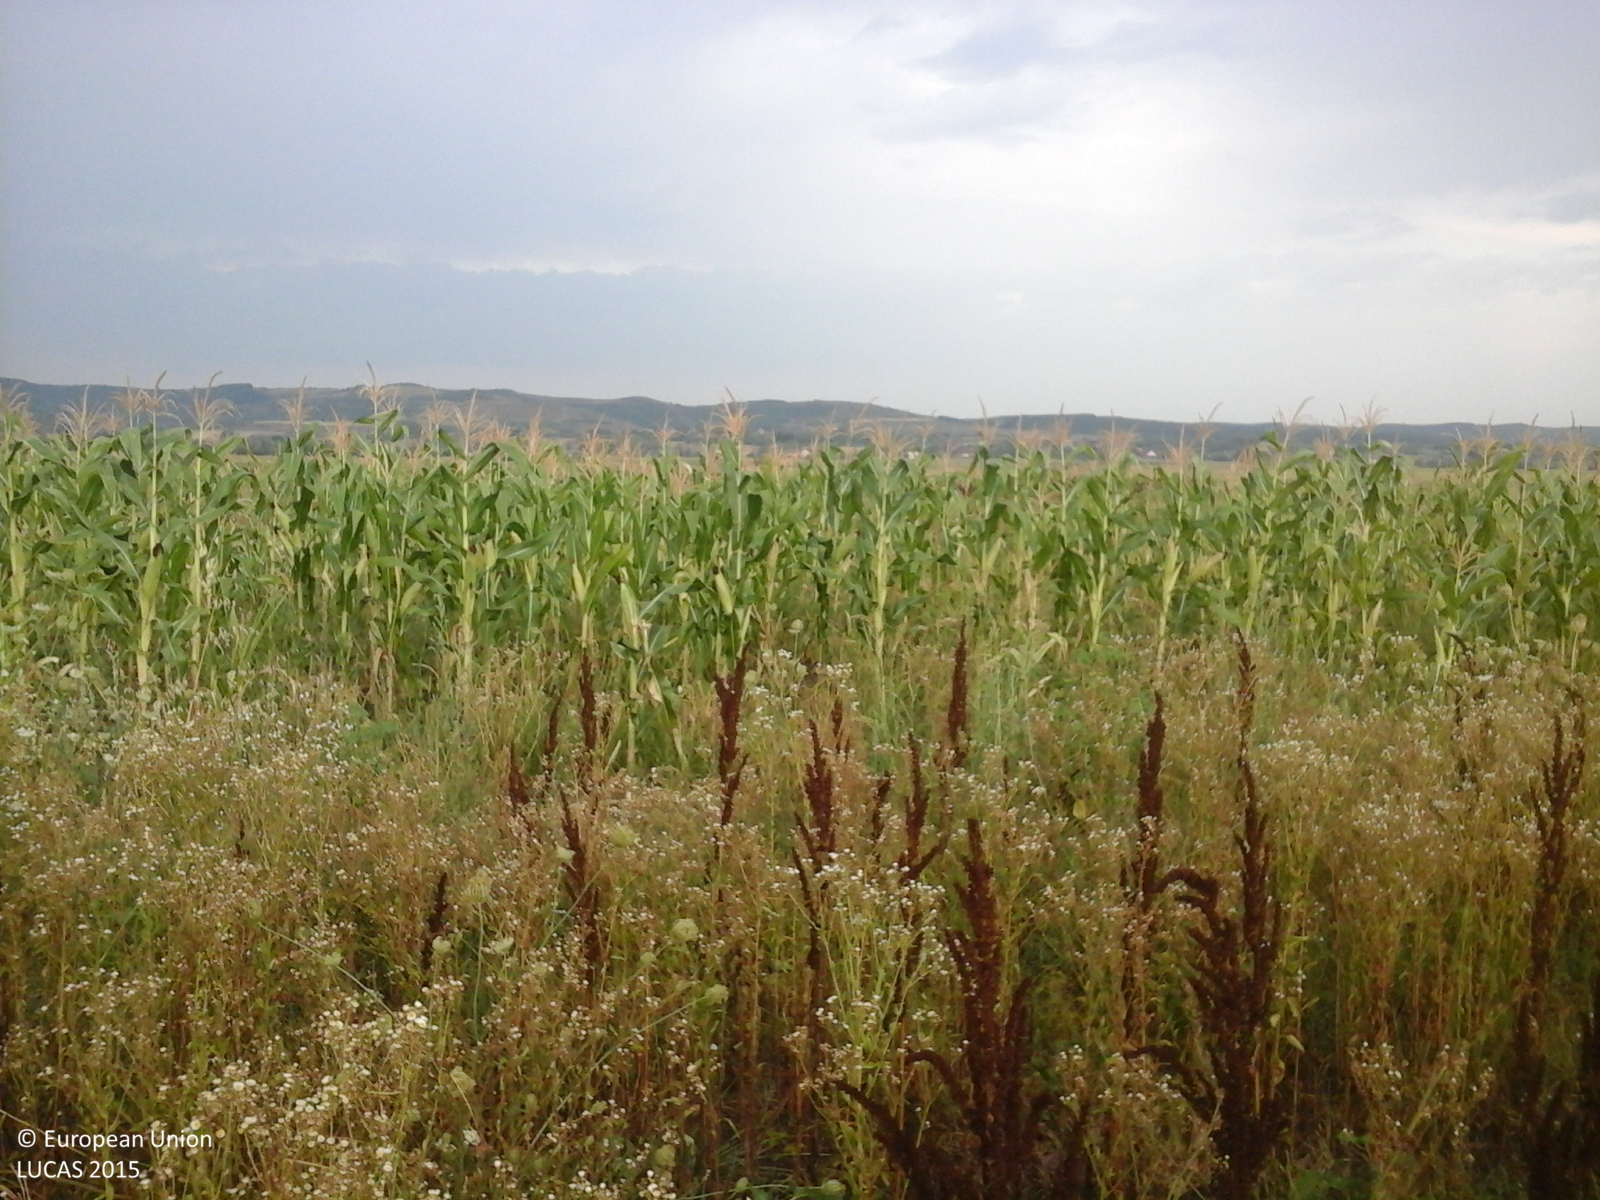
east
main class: Grassland
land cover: Spontaneously vegetated surfaces
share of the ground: > 75 %
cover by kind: herbaceous plants 100 %
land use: Fallow land
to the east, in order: Spontaneously vegetated surfaces; Maize; Spontaneously vegetated surfaces; Maize; Spontaneously vegetated surfaces; Maize; Grassland without tree/shrub cover
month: August
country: RO
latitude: 44.6674
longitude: 23.5131
